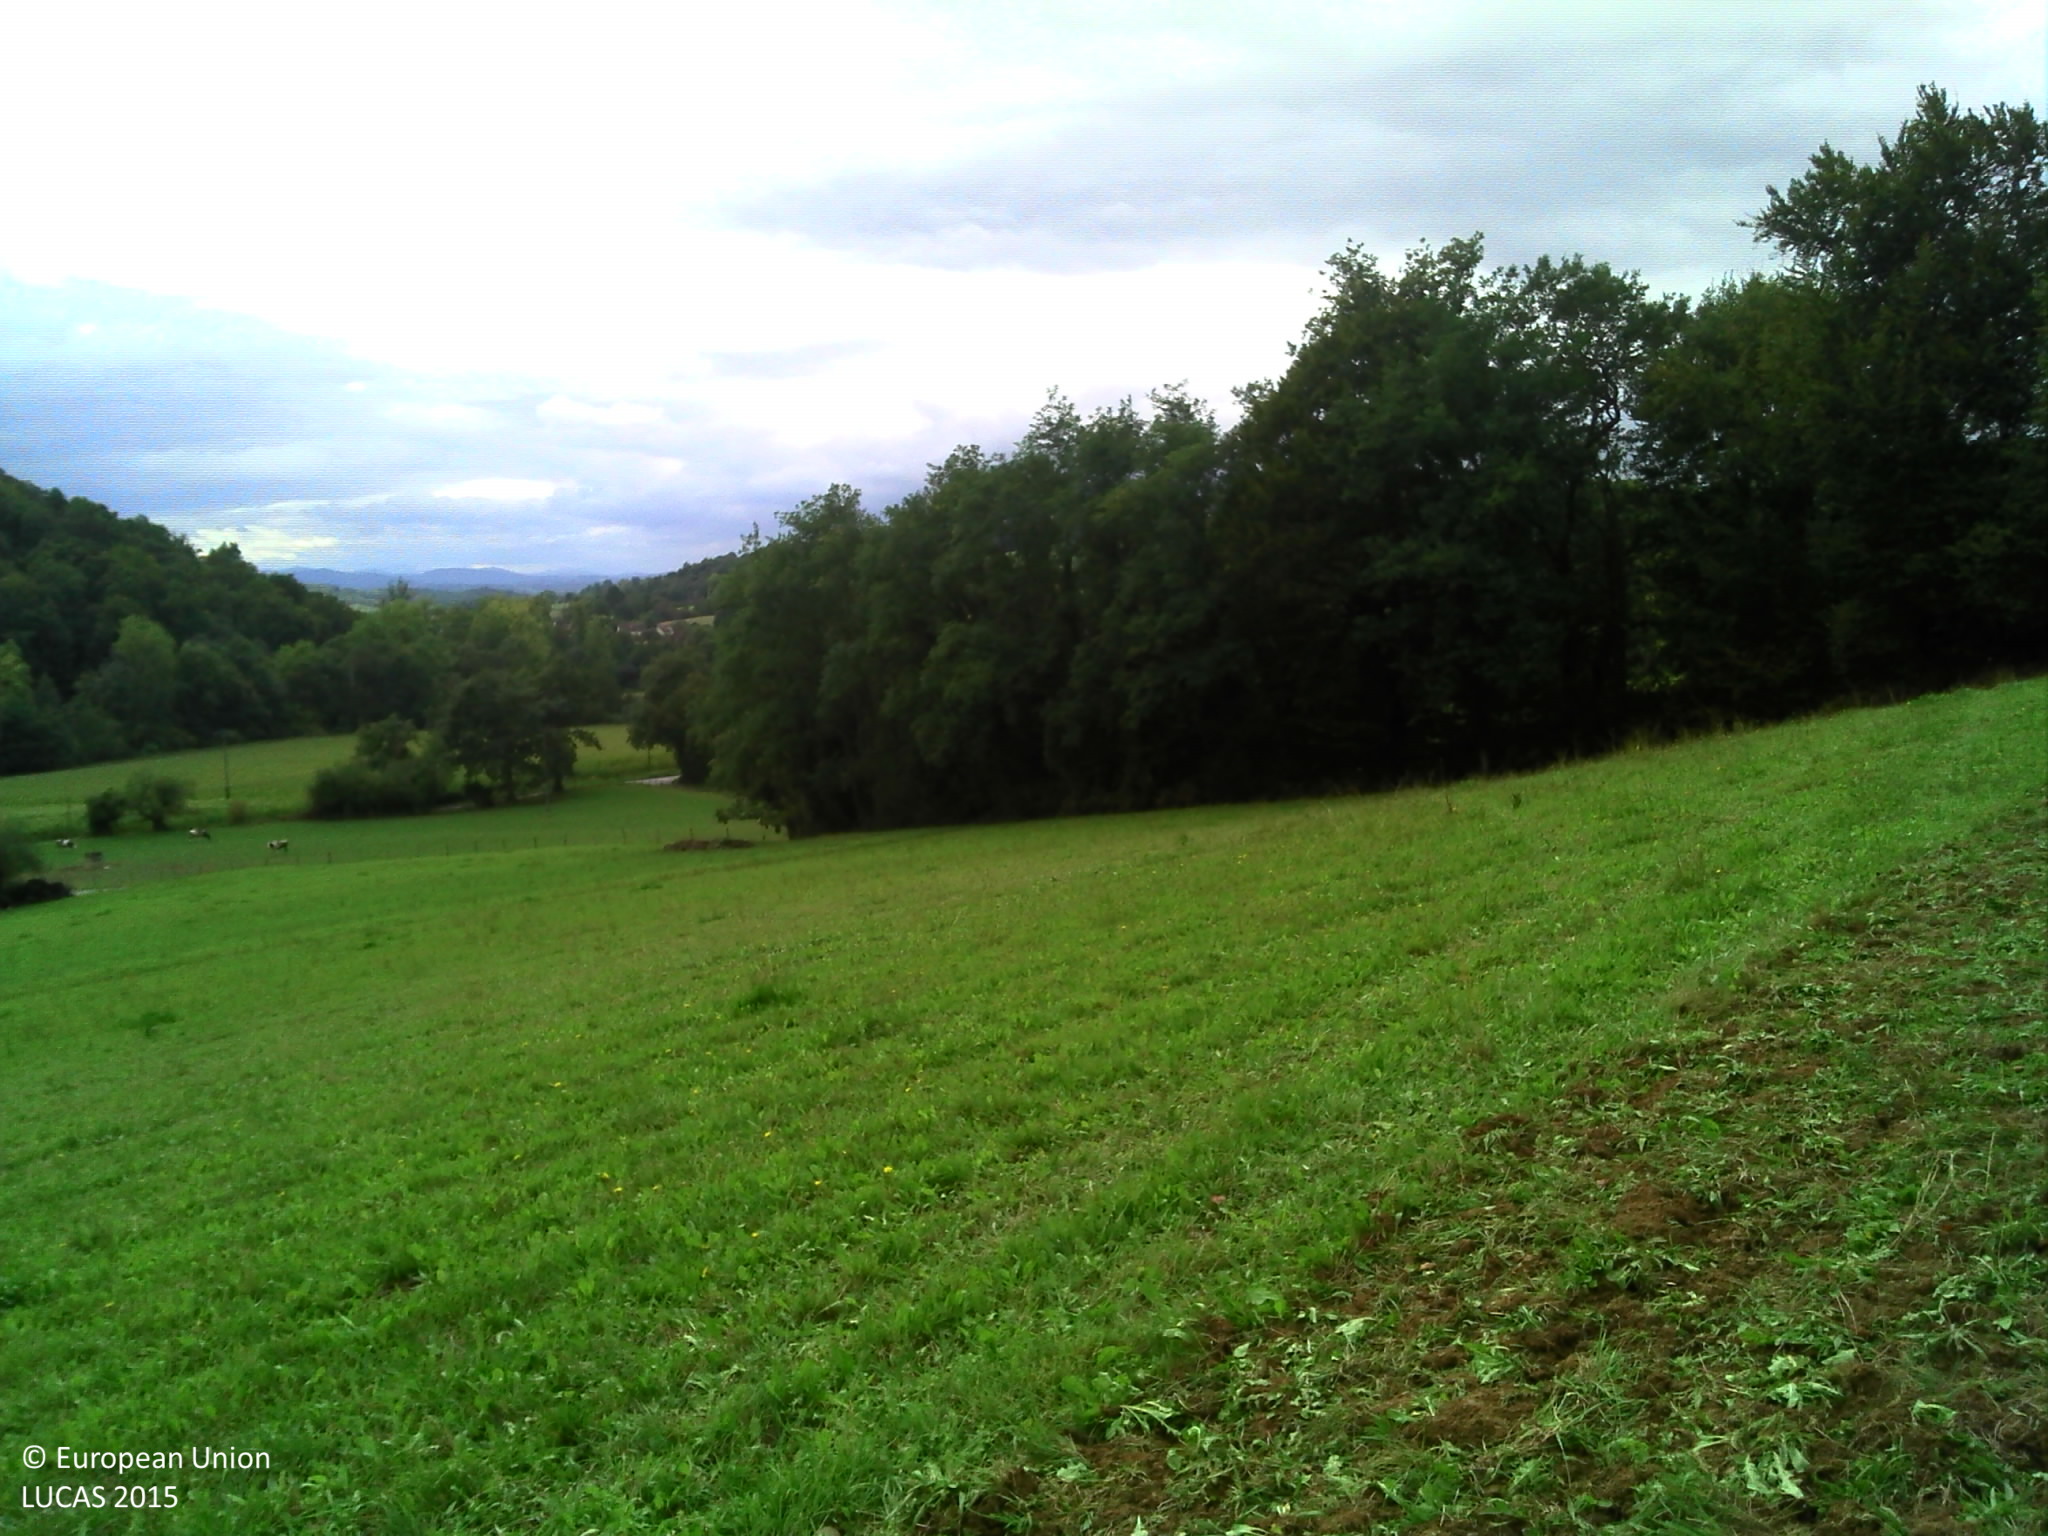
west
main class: Grassland
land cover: Grassland without tree/shrub cover
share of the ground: > 75 %
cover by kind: herbaceous plants 90 %, unconsolidated bare surface 10 %
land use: Agriculture (excluding fallow land and kitchen gardens)
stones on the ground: < 10 %
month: September
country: FR
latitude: 43.2922
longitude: -0.6457
